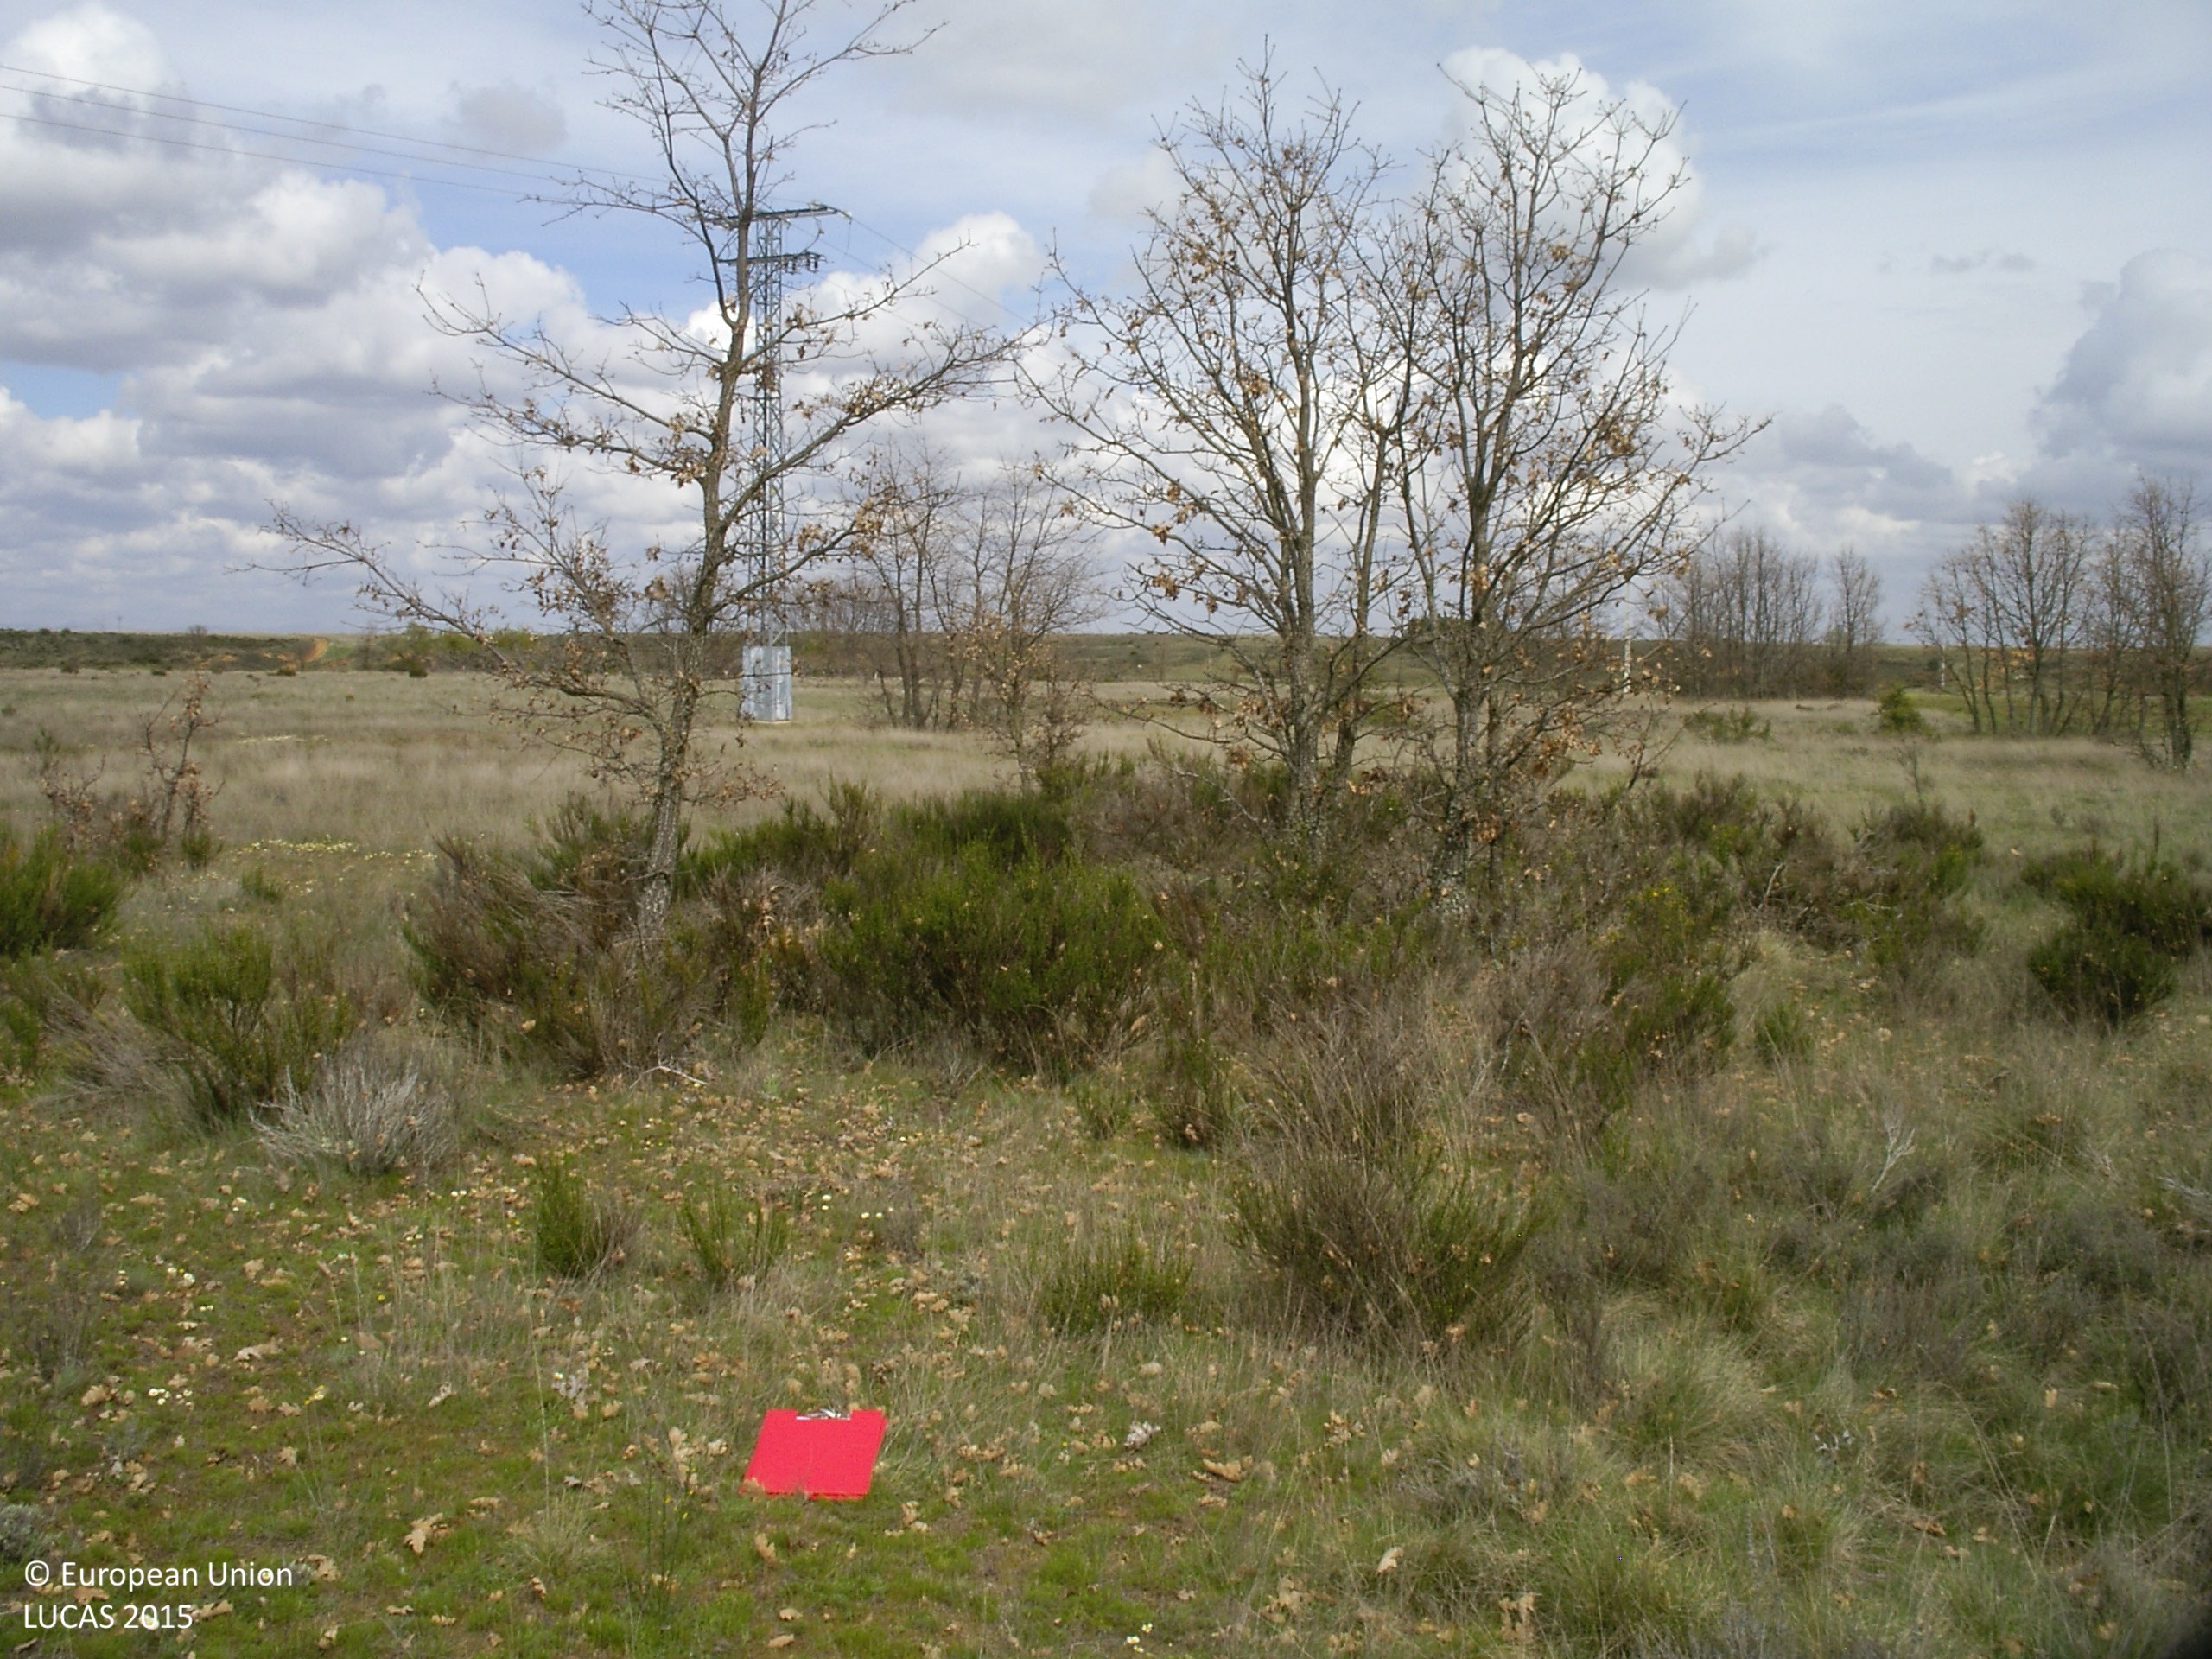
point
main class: Grassland
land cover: Grassland with sparse tree/shrub cover
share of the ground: > 75 %
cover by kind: herbaceous plants 90 %, broadleaved forest trees 5 %, shrubs 5 %
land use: Abandoned areas
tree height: > 5 m
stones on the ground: < 10 %
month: April
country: ES
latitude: 42.5551
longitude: -5.7258
